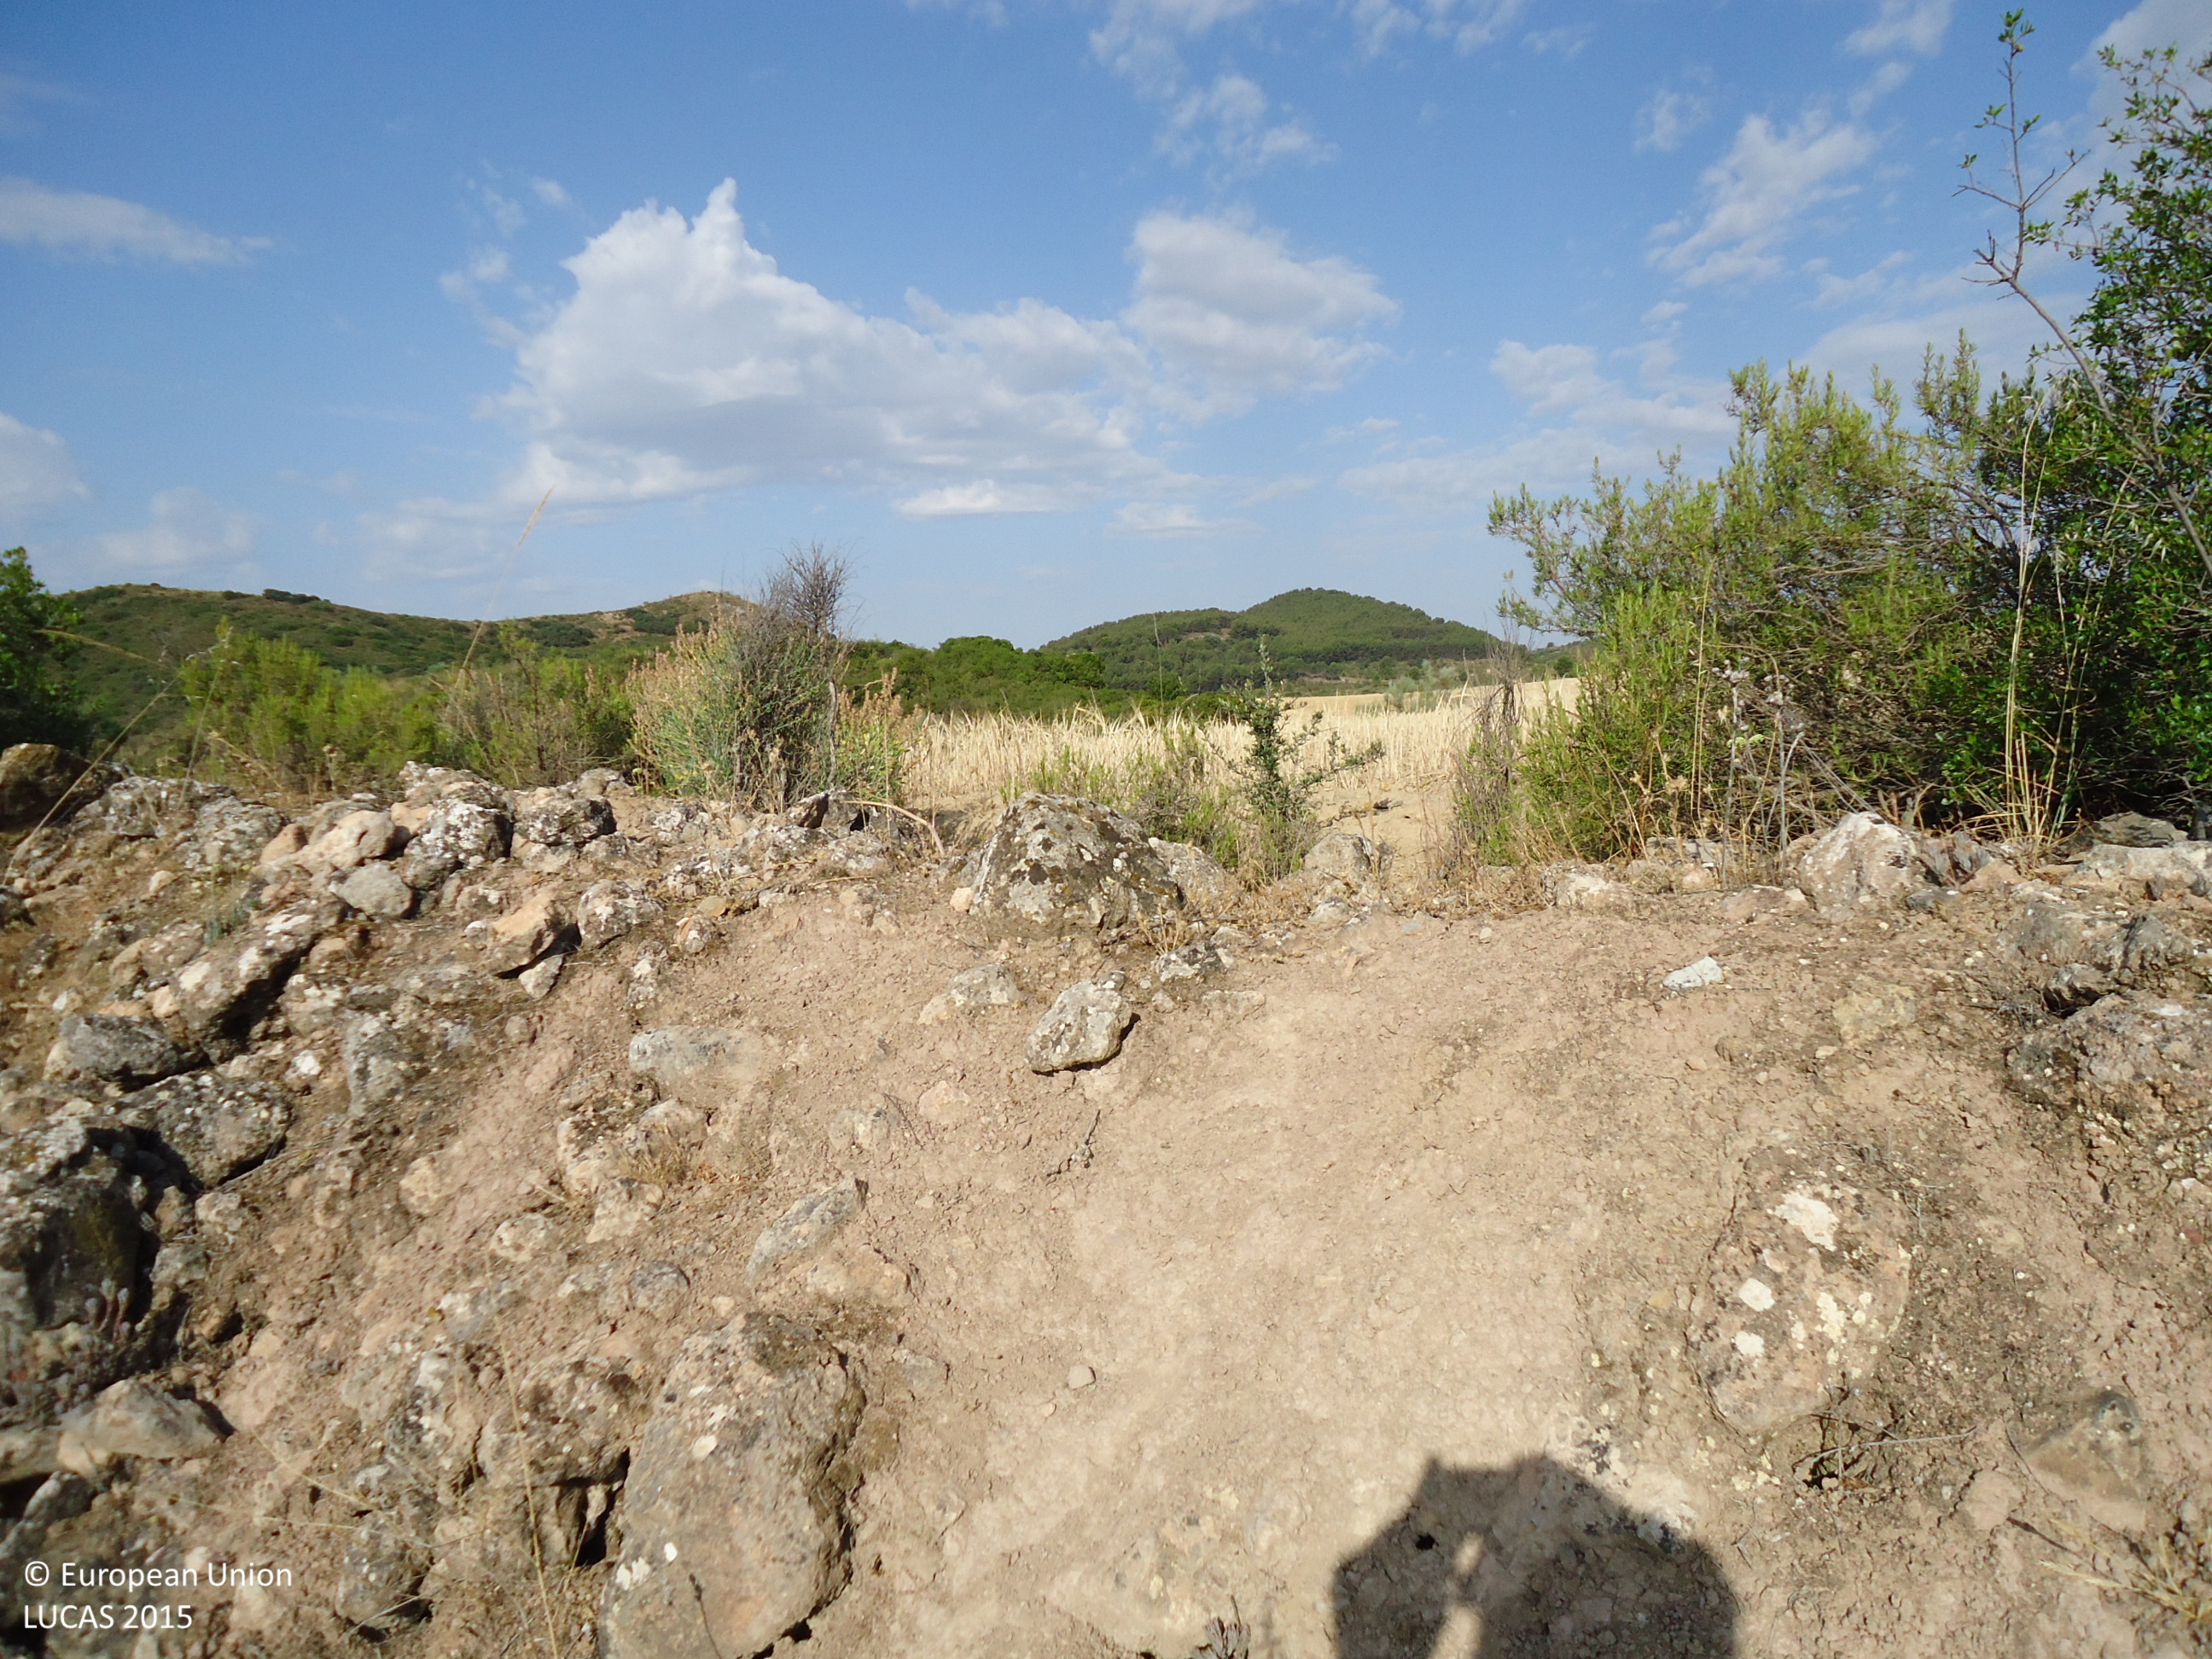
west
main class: Shrubland
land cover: Shrubland without tree cover
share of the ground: > 75 %
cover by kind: shrubs 85 %, herbaceous plants 5 %, consolidated bare surface 5 %, unconsolidated bare surface 5 %
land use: Semi-natural and natural areas not in use
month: June
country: ES
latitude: 36.9915
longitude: -4.7738
